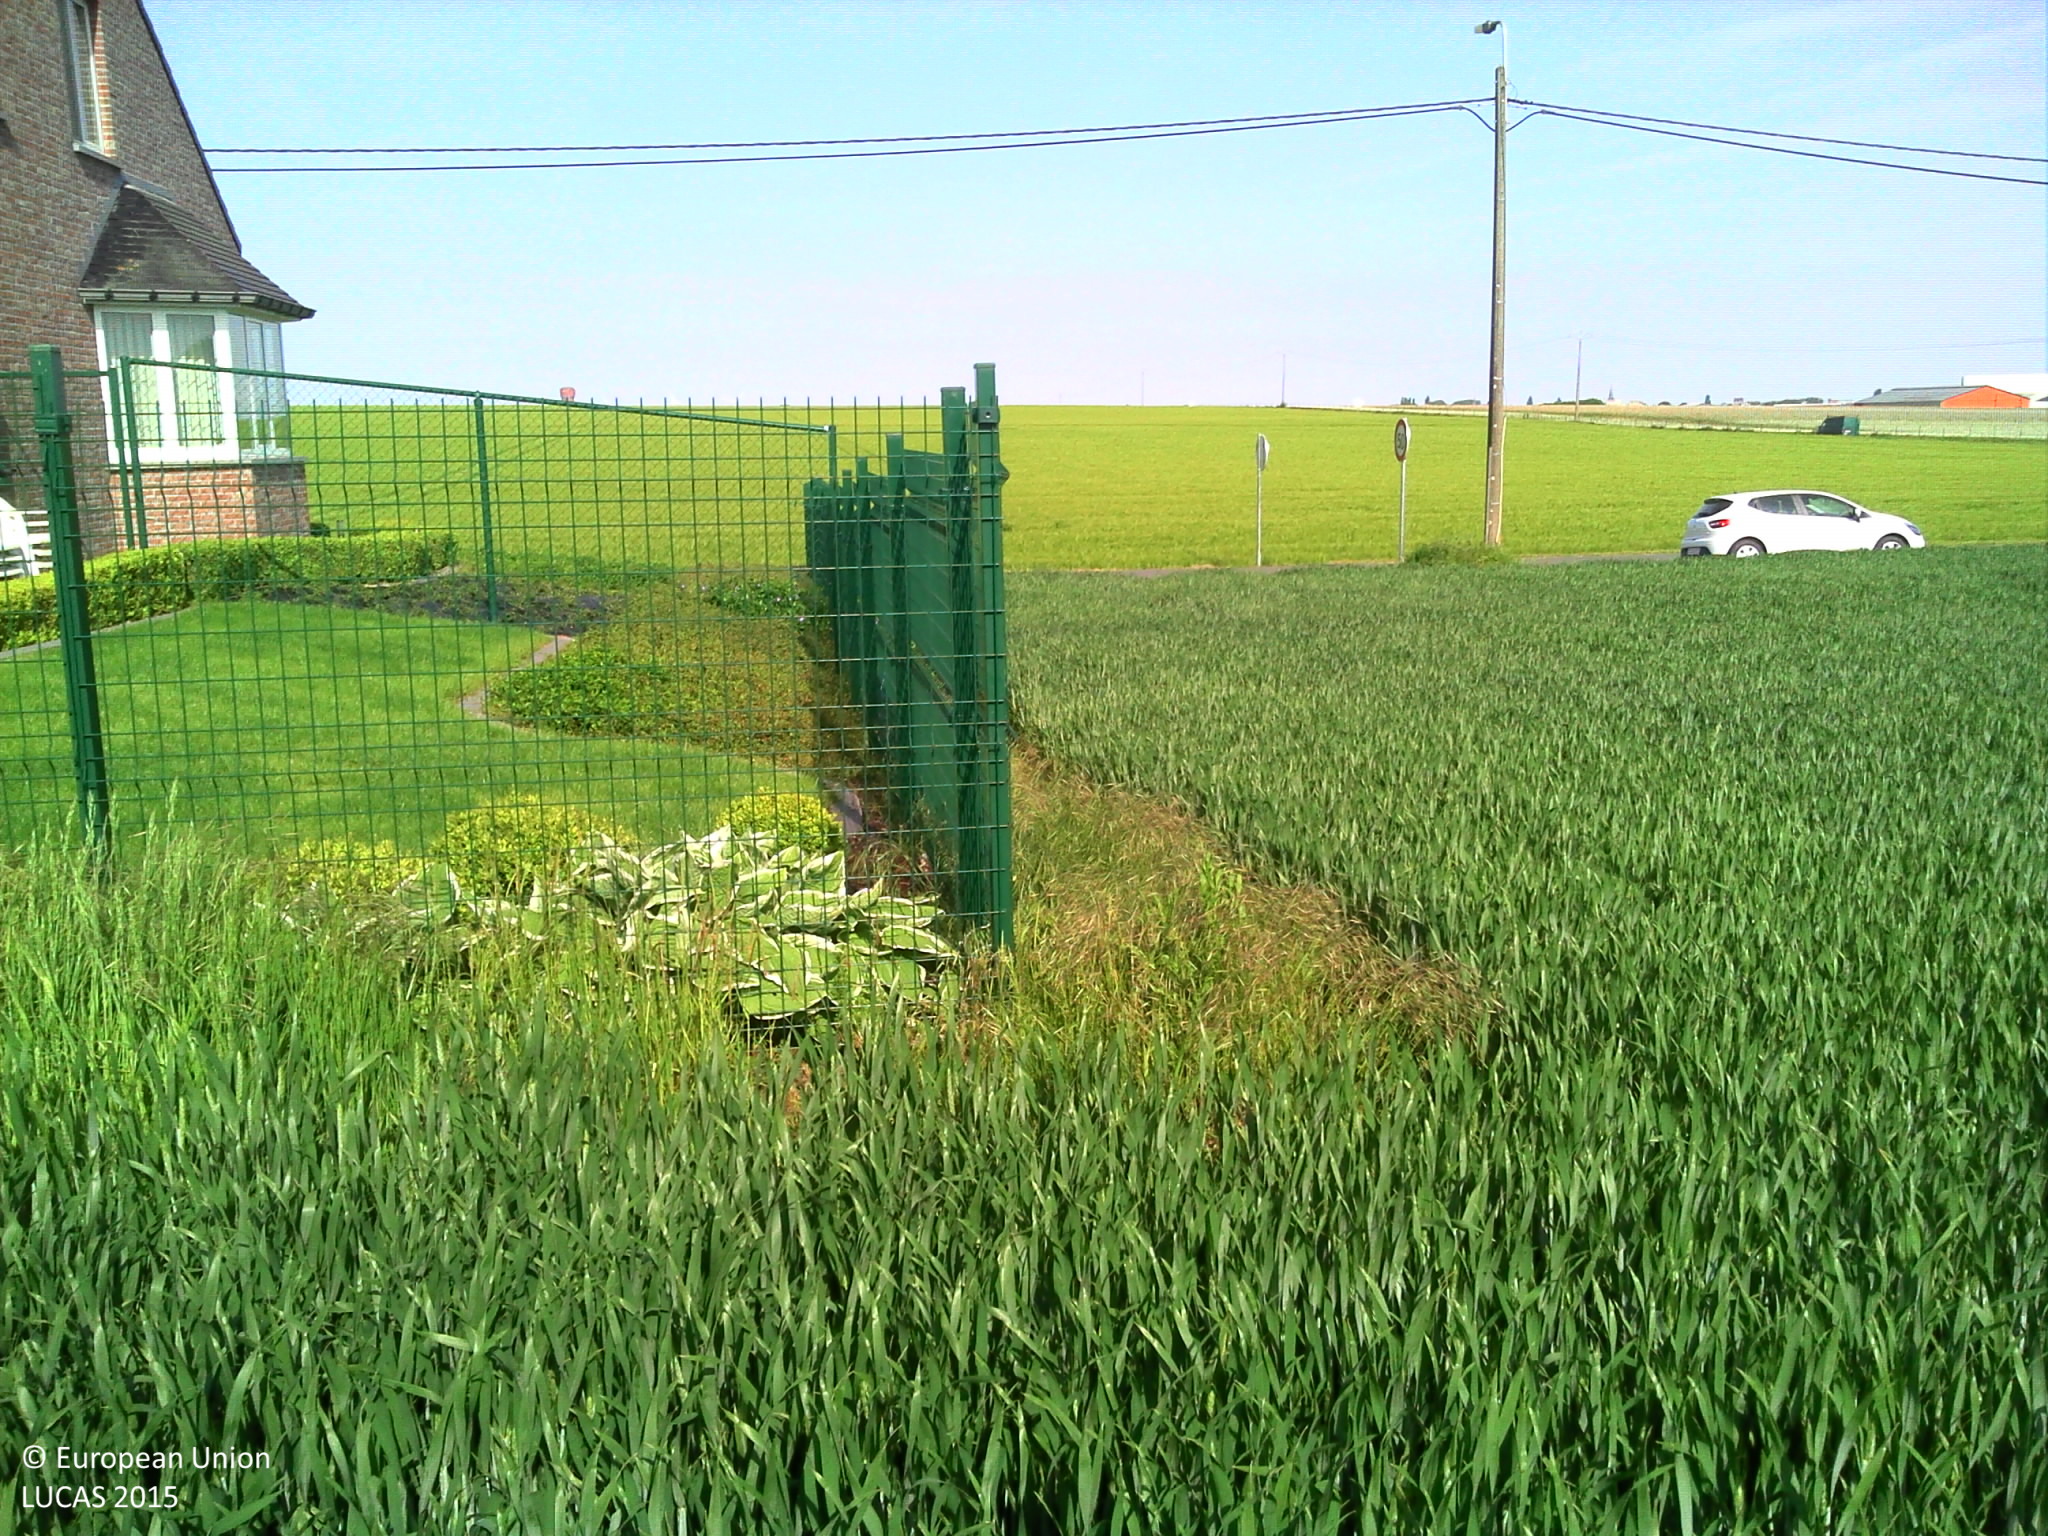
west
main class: Cropland
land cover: Common wheat
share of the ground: > 75 %
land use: Agriculture (excluding fallow land and kitchen gardens)
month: May
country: BE
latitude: 50.6812
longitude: 5.2849
